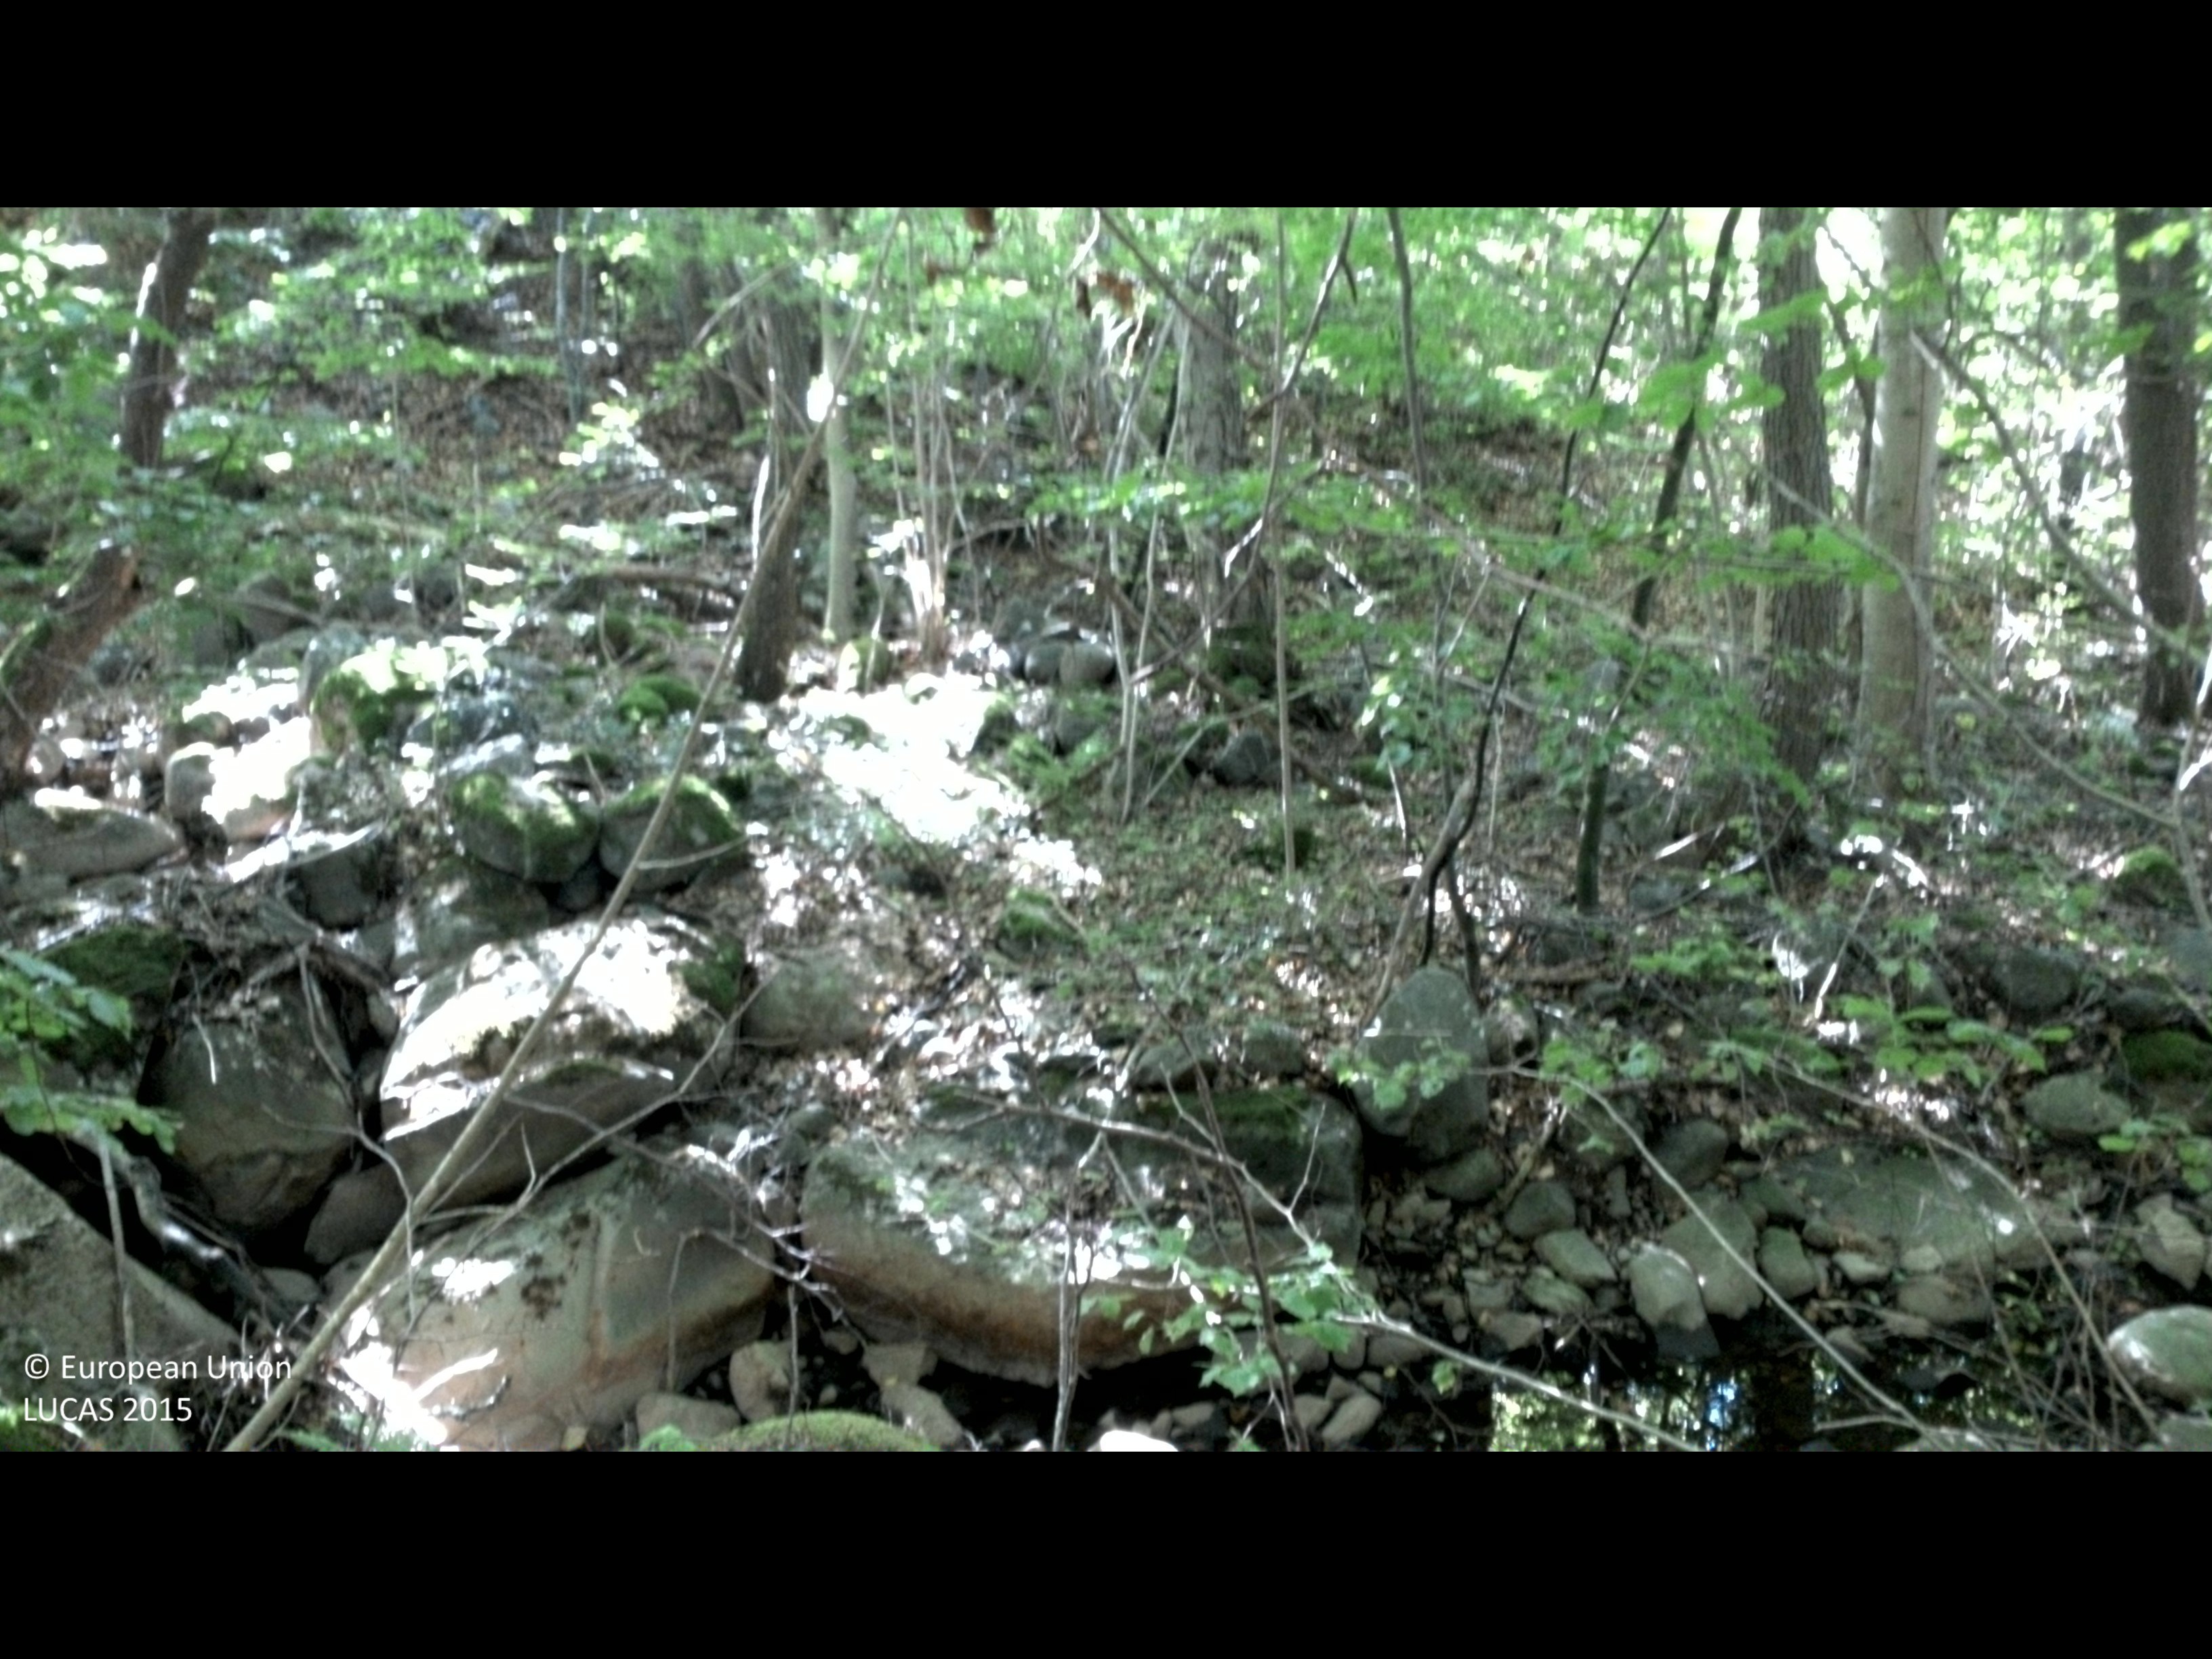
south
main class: Woodland
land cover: Broadleaved woodland
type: beech forest
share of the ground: > 75 %
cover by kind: broadleaved forest trees 90 %
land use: Forestry
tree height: > 5 m
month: September
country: SE
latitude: 56.1688
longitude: 14.3301
